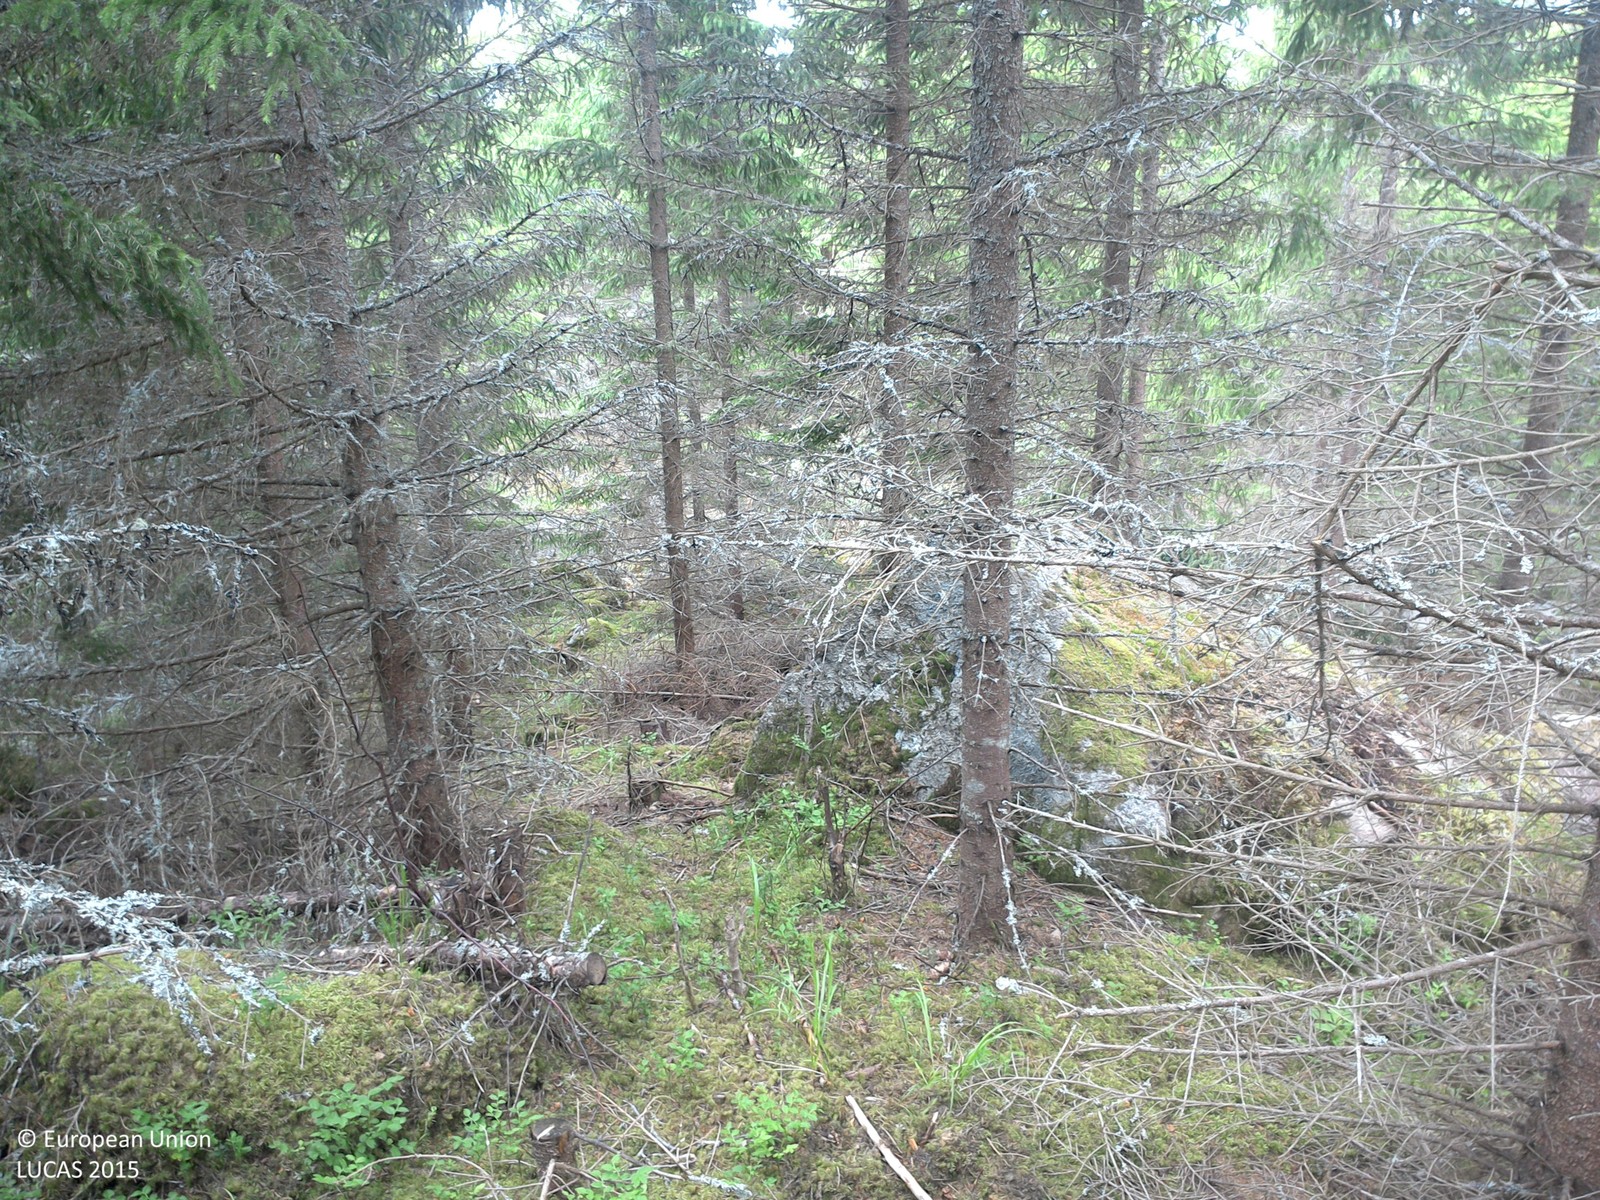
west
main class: Woodland
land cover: Spruce dominated coniferous woodland
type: boreal forest
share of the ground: 50 - 75 %
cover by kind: coniferous forest trees 60 %, lichens and mosses 40 %
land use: Forestry
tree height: > 5 m
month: June
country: SE
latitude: 58.0132
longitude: 16.0050
